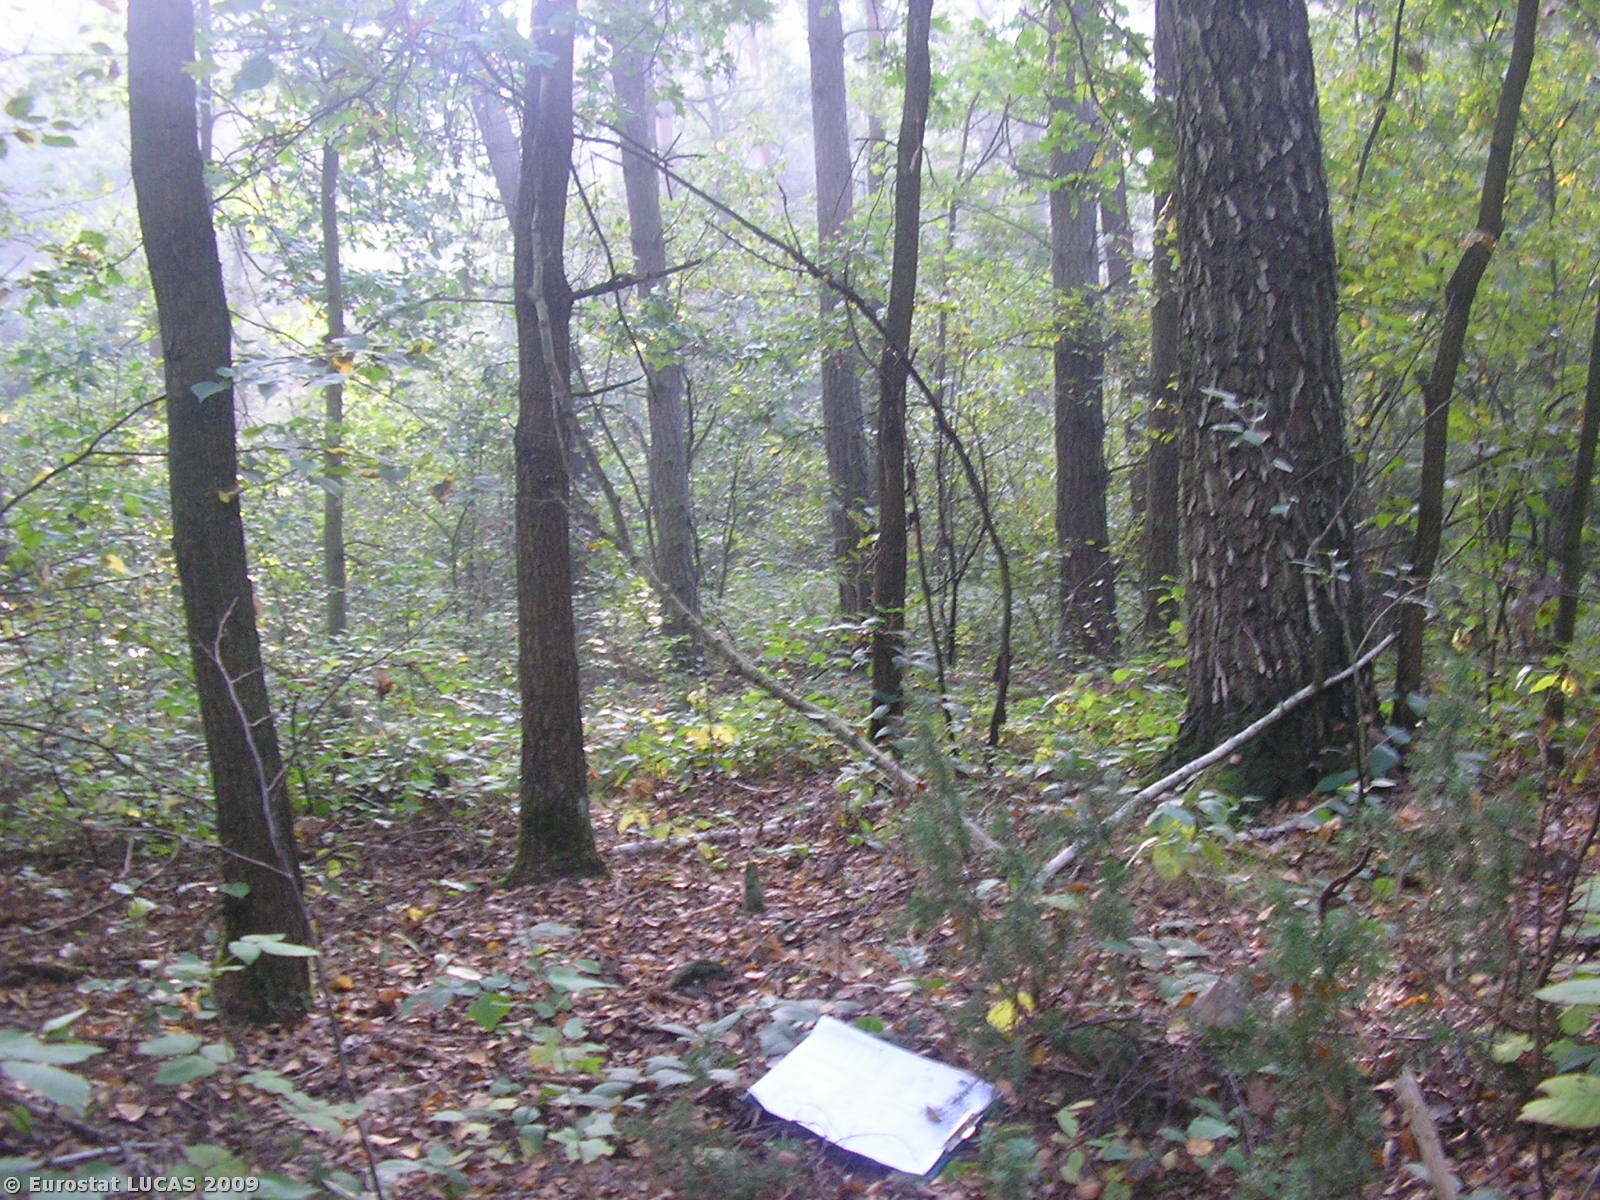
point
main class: Woodland
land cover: Mixed woodland
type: hemiboreal forest and nemoral coniferous forest and mixed broadleaved-coniferous forest
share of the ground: > 75 %
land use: Forestry
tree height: > 5 m
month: September
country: PL
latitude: 51.8701
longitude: 20.7452
